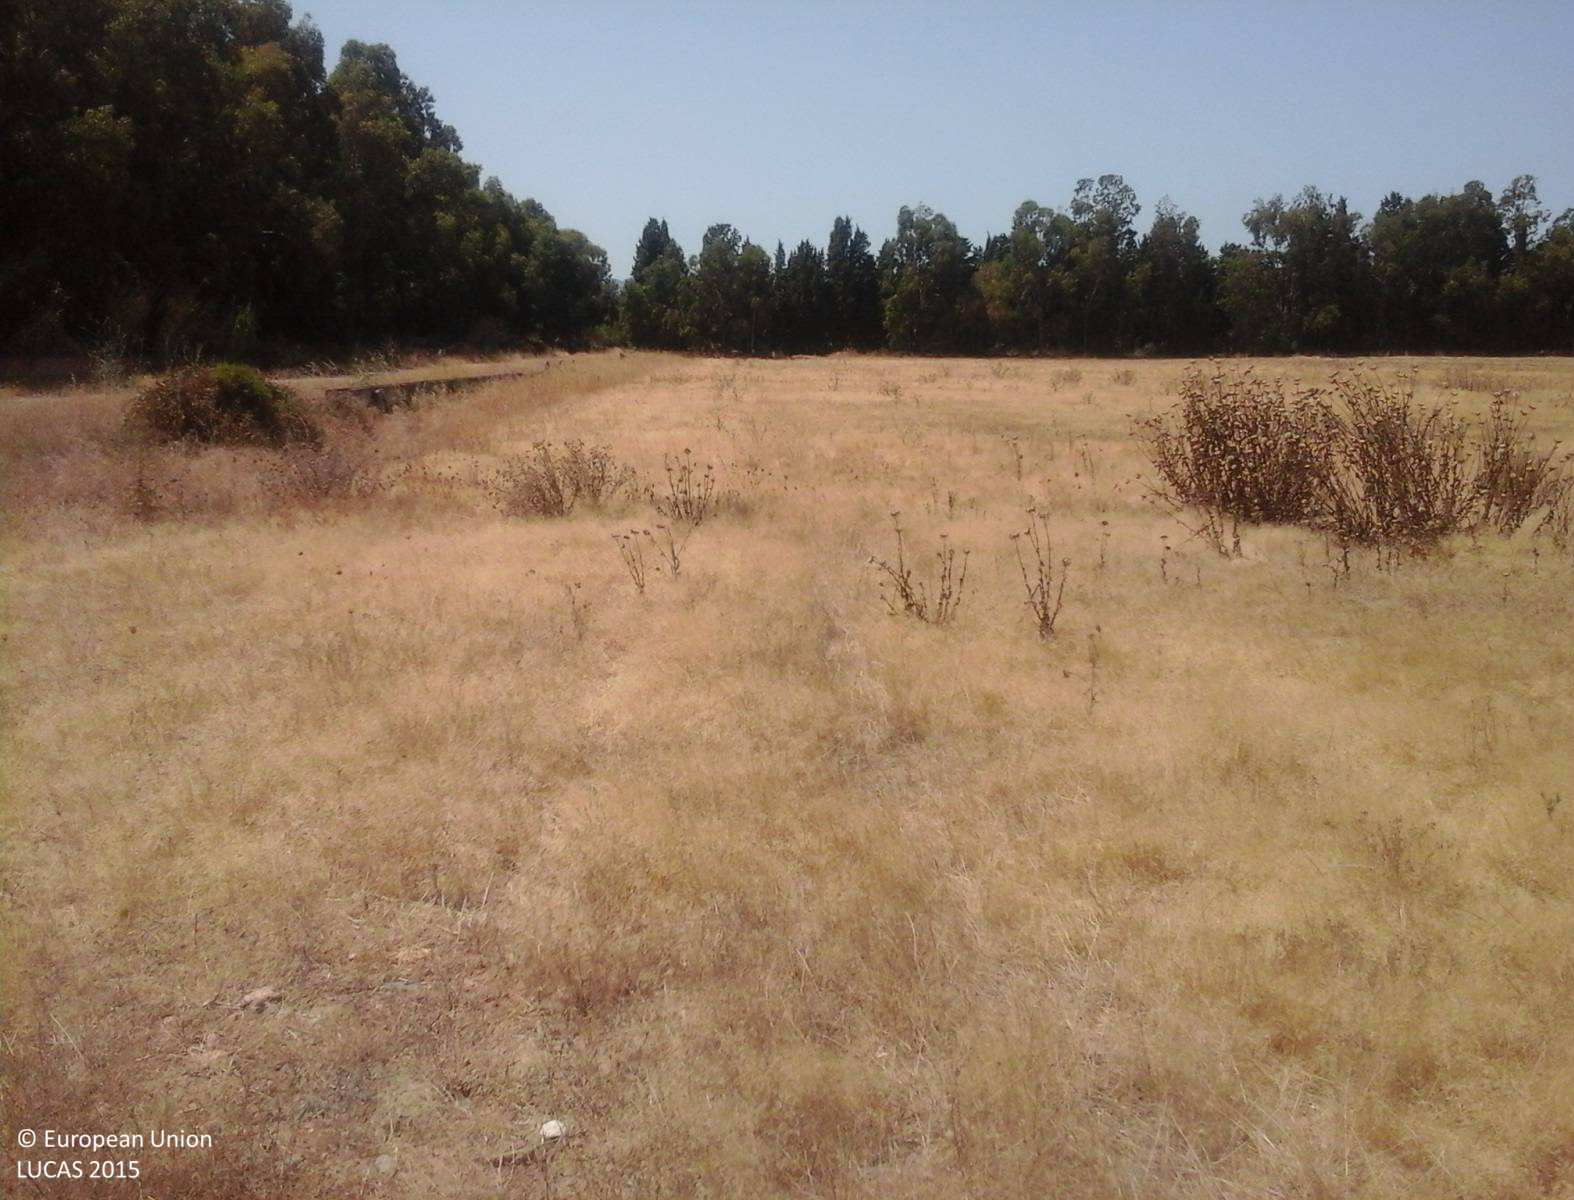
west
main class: Cropland
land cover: Mixed cereals for fodder
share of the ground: > 75 %
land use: Agriculture (excluding fallow land and kitchen gardens)
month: August
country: IT
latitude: 39.4459
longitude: 8.8796
